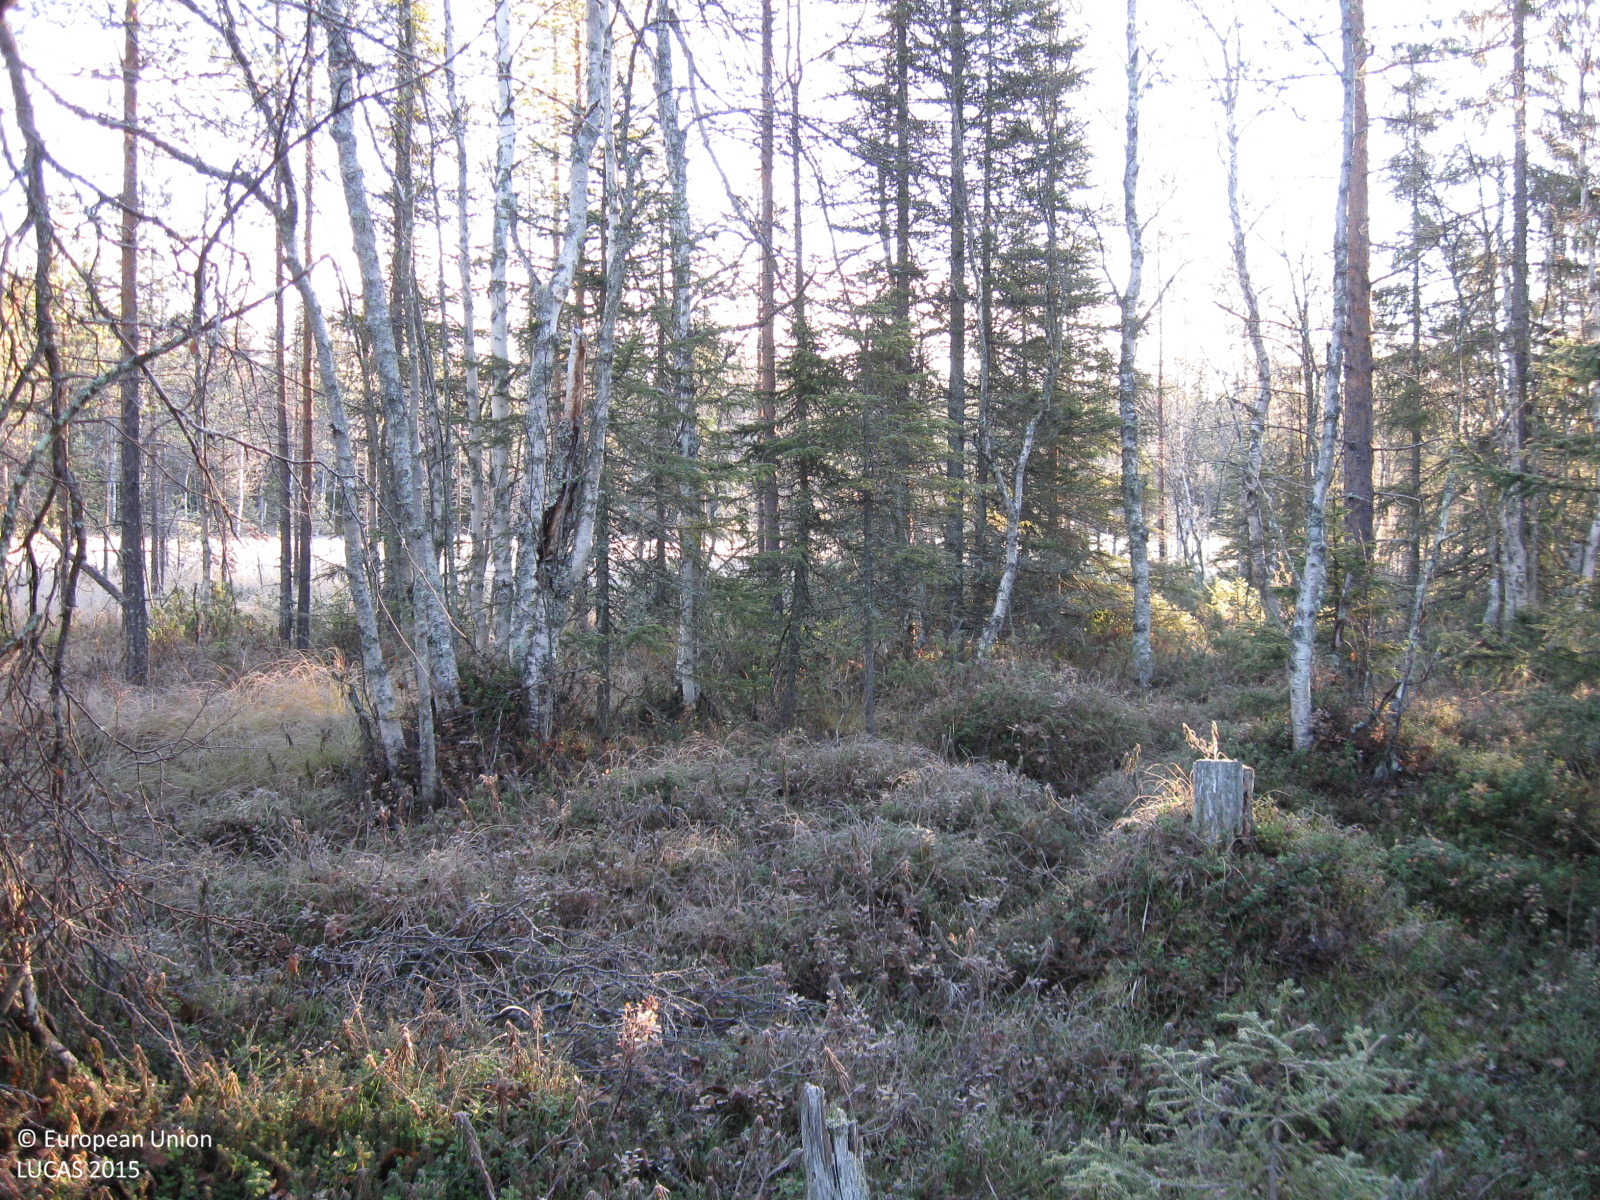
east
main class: Woodland
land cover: Pine dominated mixed woodland
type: mire and swamp forests
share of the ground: > 75 %
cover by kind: coniferous forest trees 45 %, broadleaved forest trees 30 %, shrubs 10 %, lichens and mosses 10 %, herbaceous plants 5 %
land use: Semi-natural and natural areas not in use
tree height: > 5 m
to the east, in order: Pine dominated mixed woodland; Peatbogs; Spruce dominated mixed woodland; Pine dominated mixed woodland
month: October
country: SE
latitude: 66.2292
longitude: 22.0431
